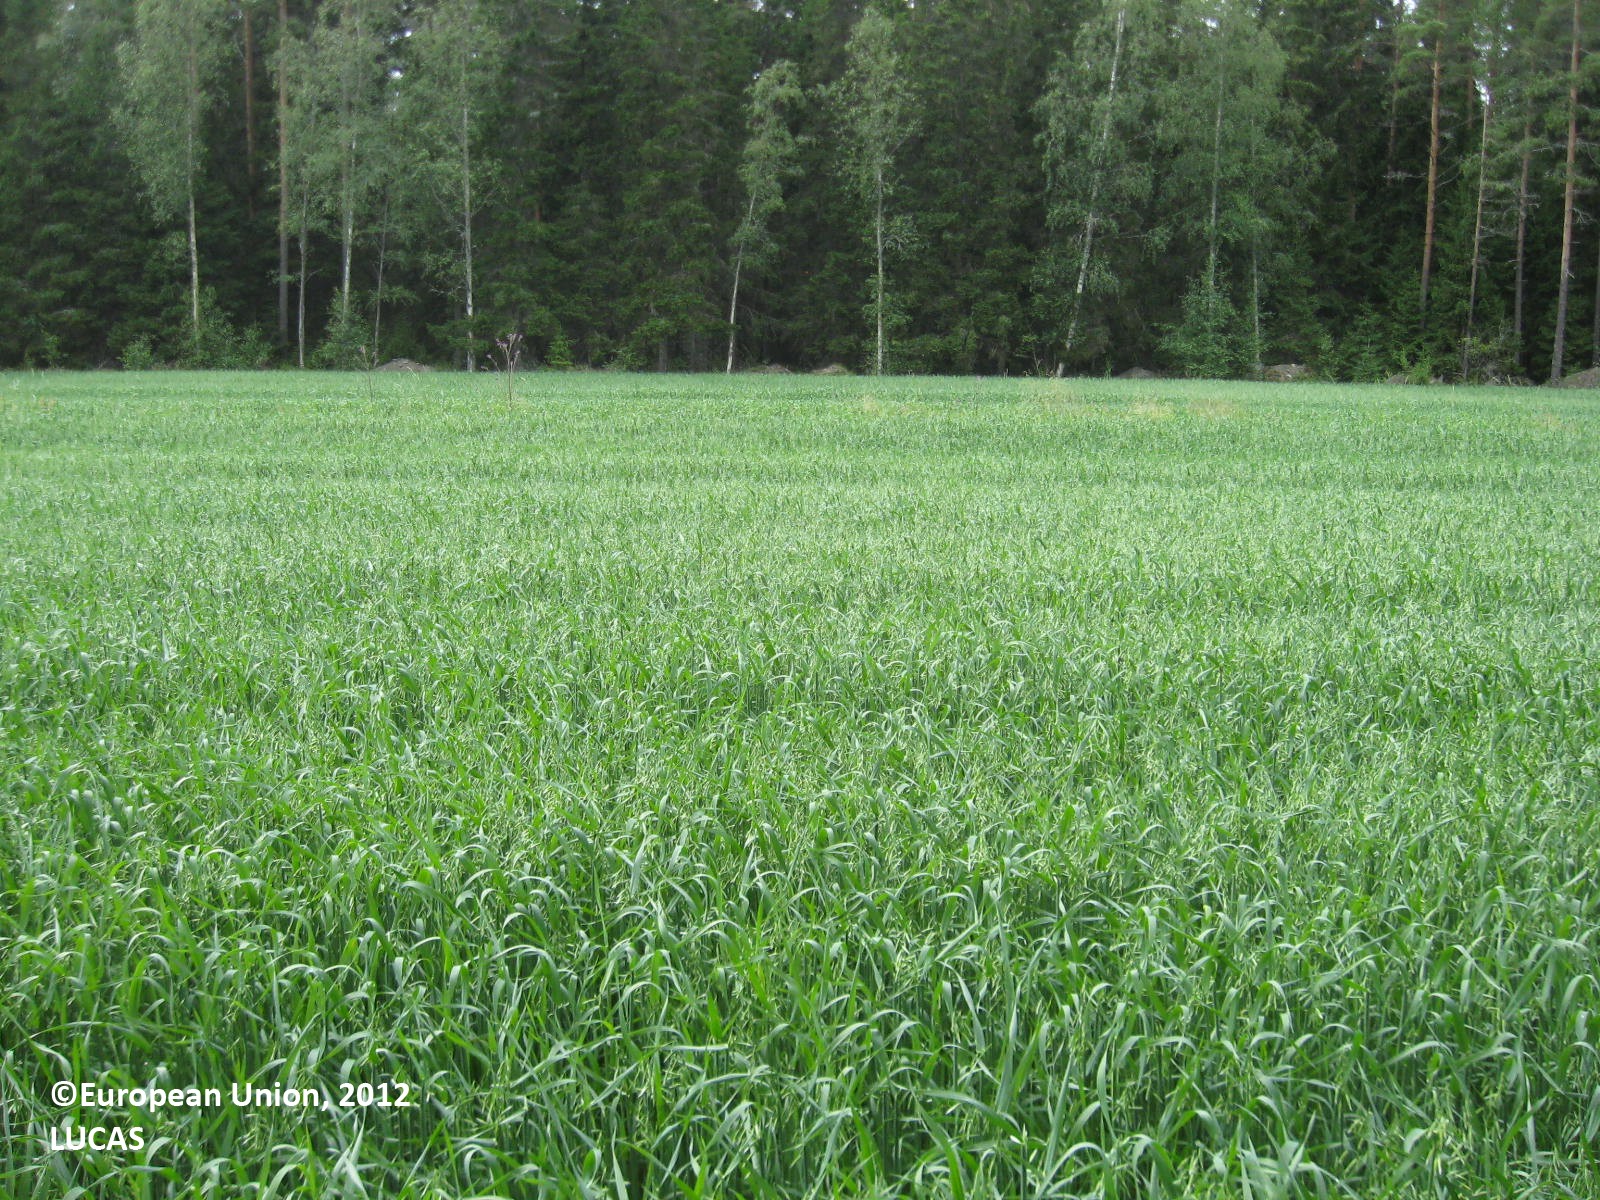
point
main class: Cropland
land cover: Oats
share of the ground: > 75 %
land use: Agriculture (excluding fallow land and kitchen gardens)
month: July
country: FI
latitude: 62.5770
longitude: 21.1917
